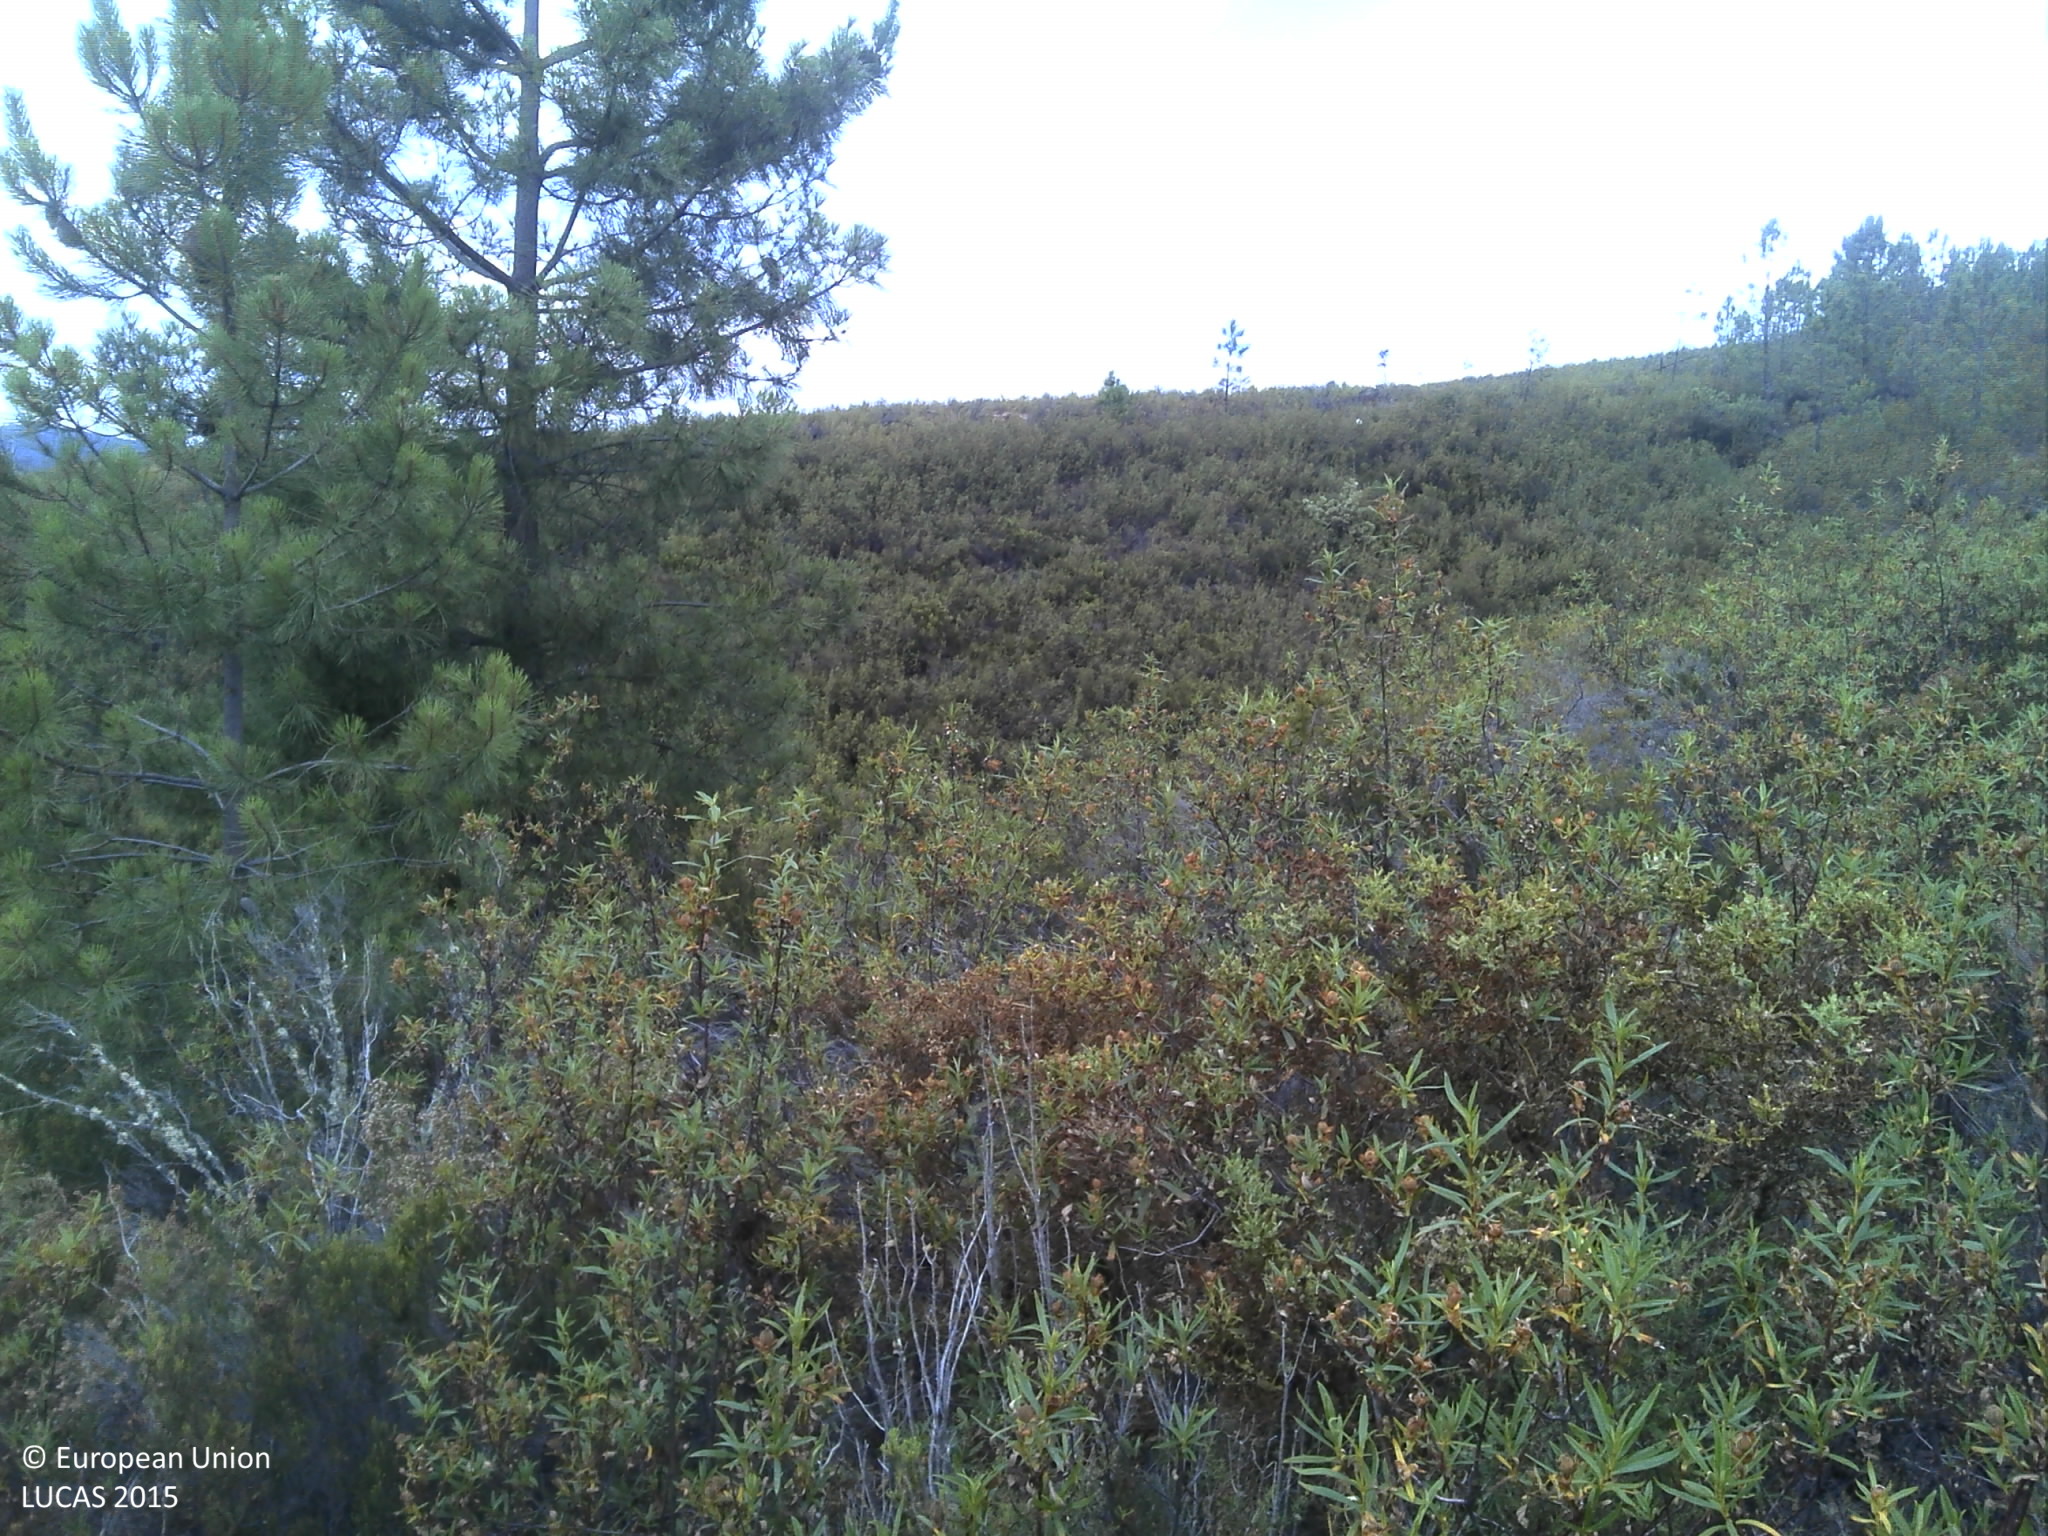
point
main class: Woodland
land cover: Pine dominated coniferous woodland
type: coniferous forest of the mediterranean region
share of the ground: 10 - 25 %
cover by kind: shrubs 55 %, coniferous forest trees 25 %, unconsolidated bare surface 20 %
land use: Forestry
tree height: > 5 m
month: June
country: PT
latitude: 40.1266
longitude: -7.3633
